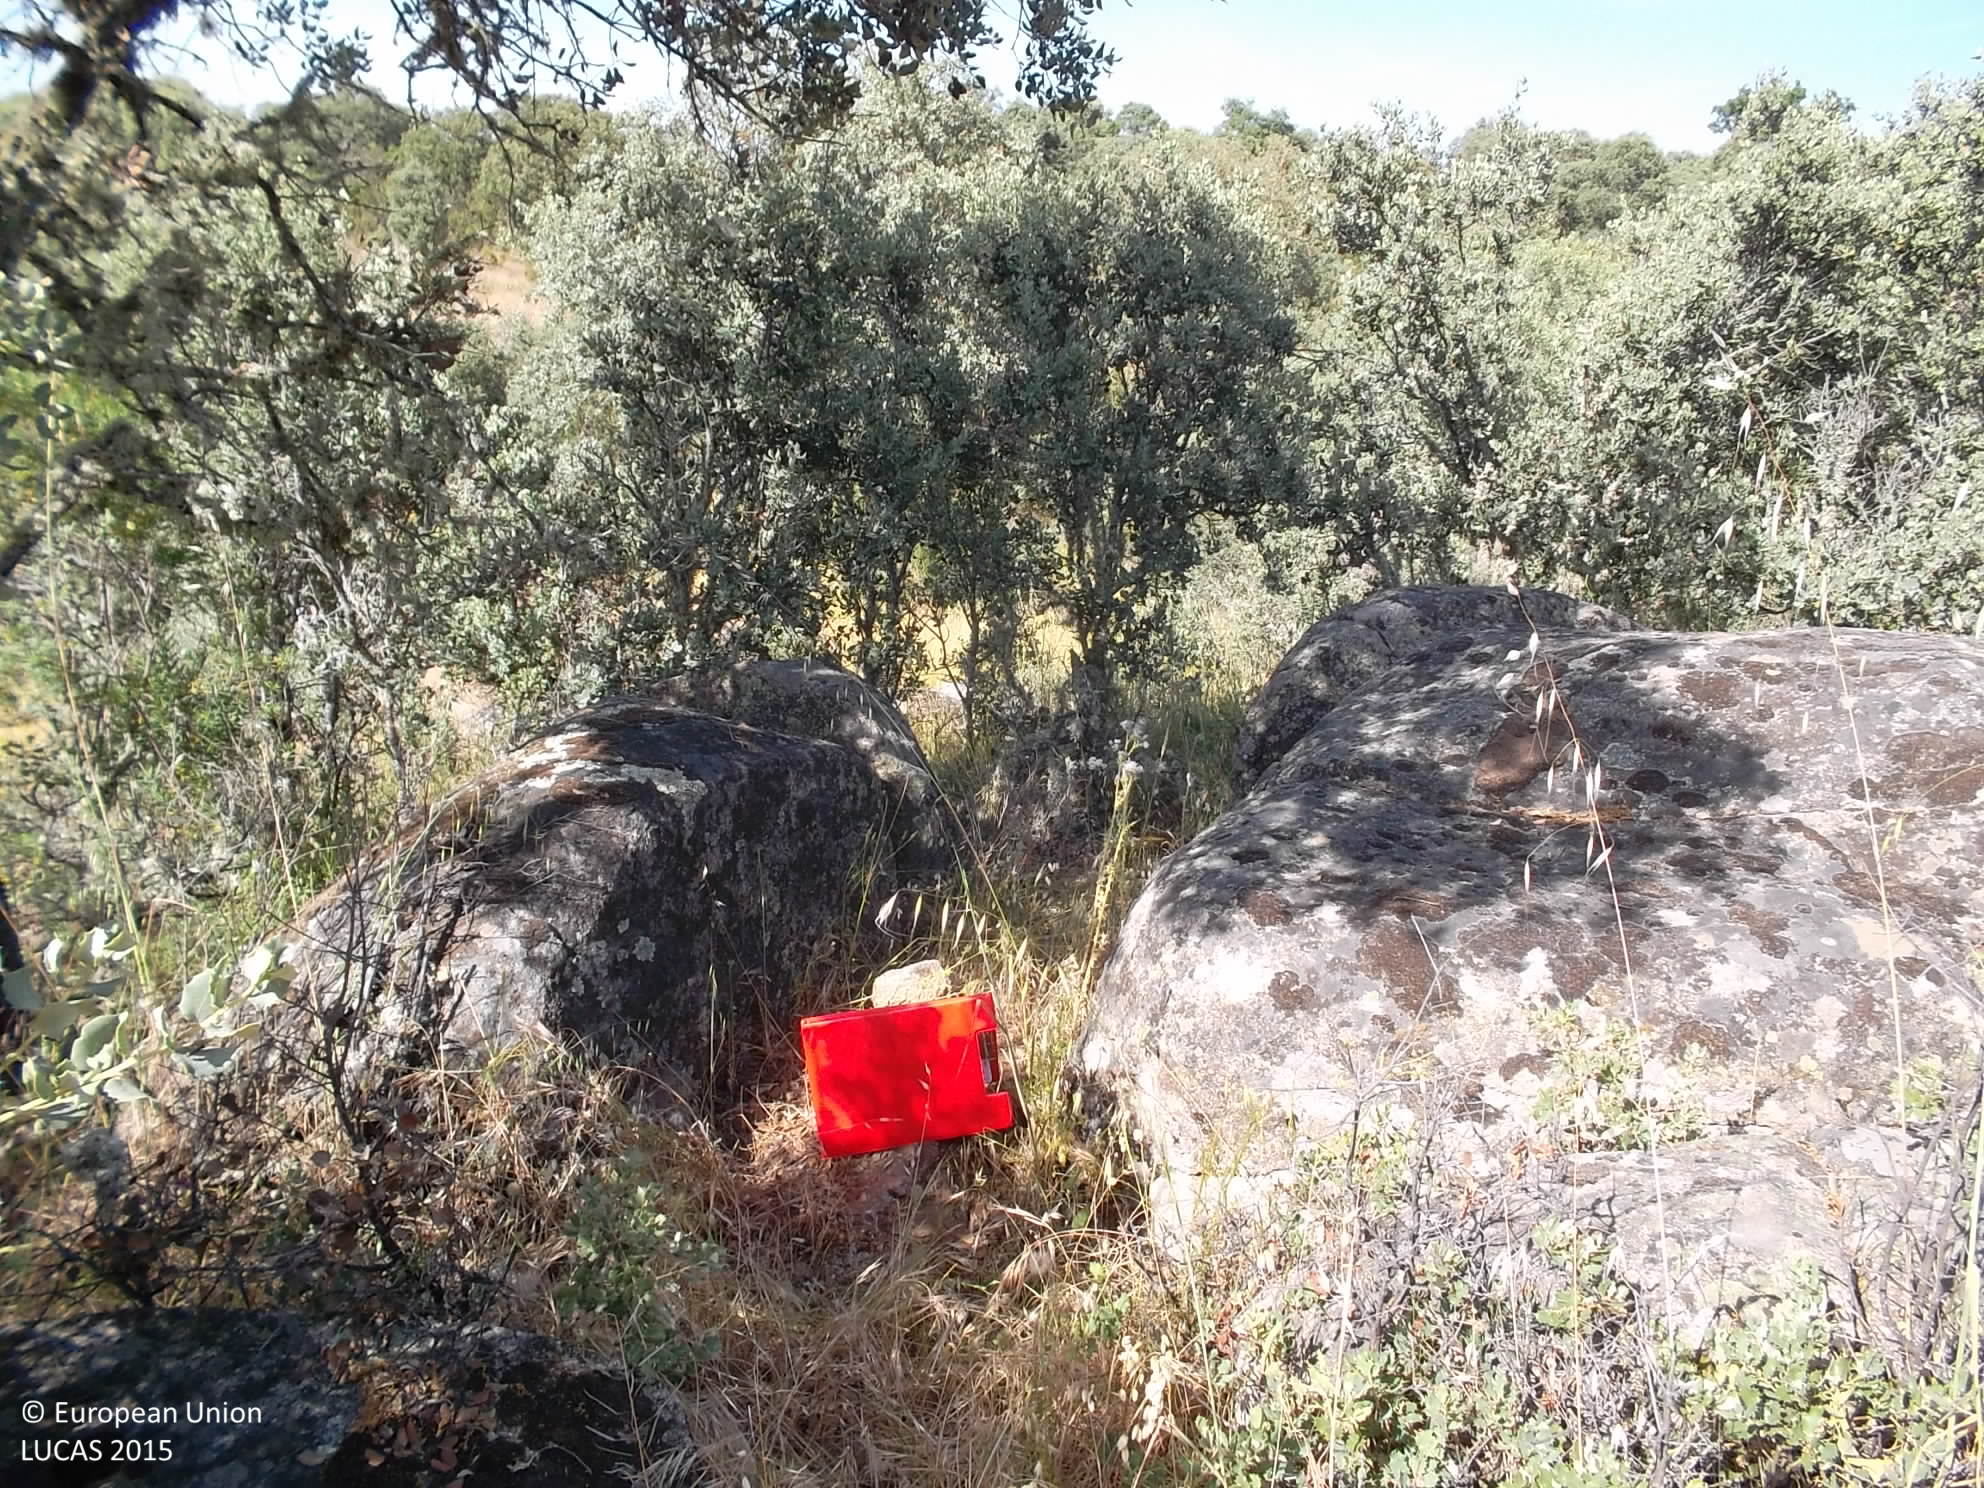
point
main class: Woodland
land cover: Broadleaved woodland
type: broadleaved evergreen forest
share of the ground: 25 - 50 %
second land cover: Shrubland without tree cover
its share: 50 - 75 %
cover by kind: broadleaved forest trees 40 %, shrubs 40 %, herbaceous plants 20 %
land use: Forestry
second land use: Agriculture (excluding fallow land and kitchen gardens)
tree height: < 5 m
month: May
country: ES
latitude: 38.7773
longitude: -4.5171
